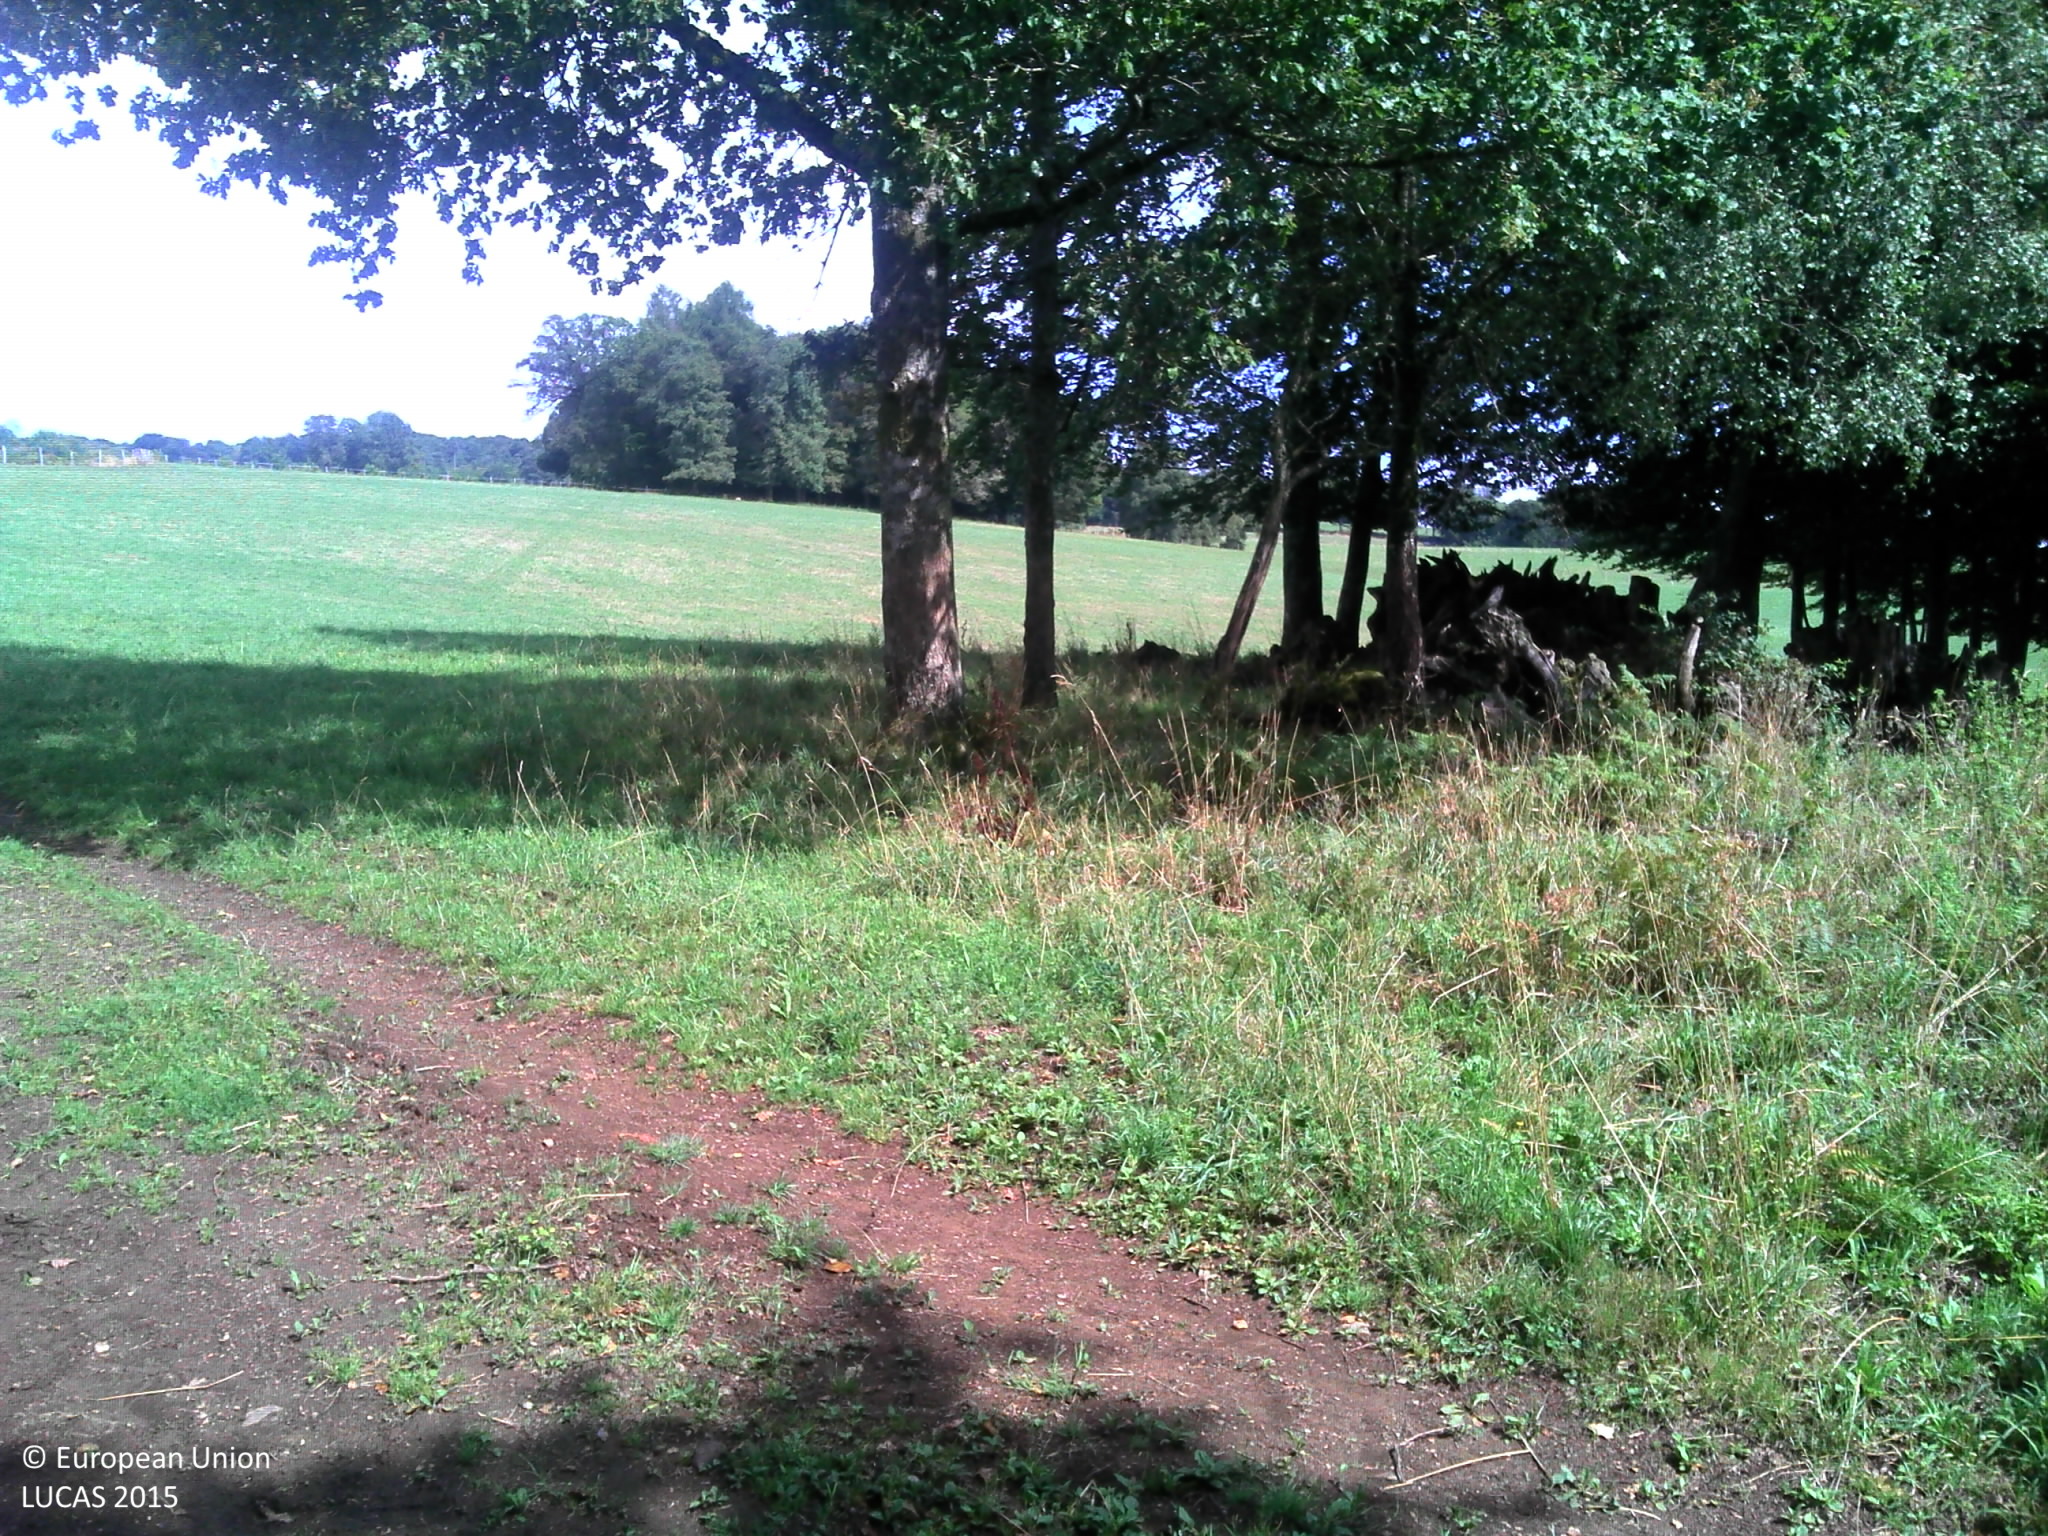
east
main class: Grassland
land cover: Grassland without tree/shrub cover
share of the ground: > 75 %
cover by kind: herbaceous plants 100 %
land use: Agriculture (excluding fallow land and kitchen gardens)
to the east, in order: Grassland without tree/shrub cover; Fences; Abandoned hedges; Grassland without tree/shrub cover
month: August
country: FR
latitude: 45.4546
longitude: 1.7730
